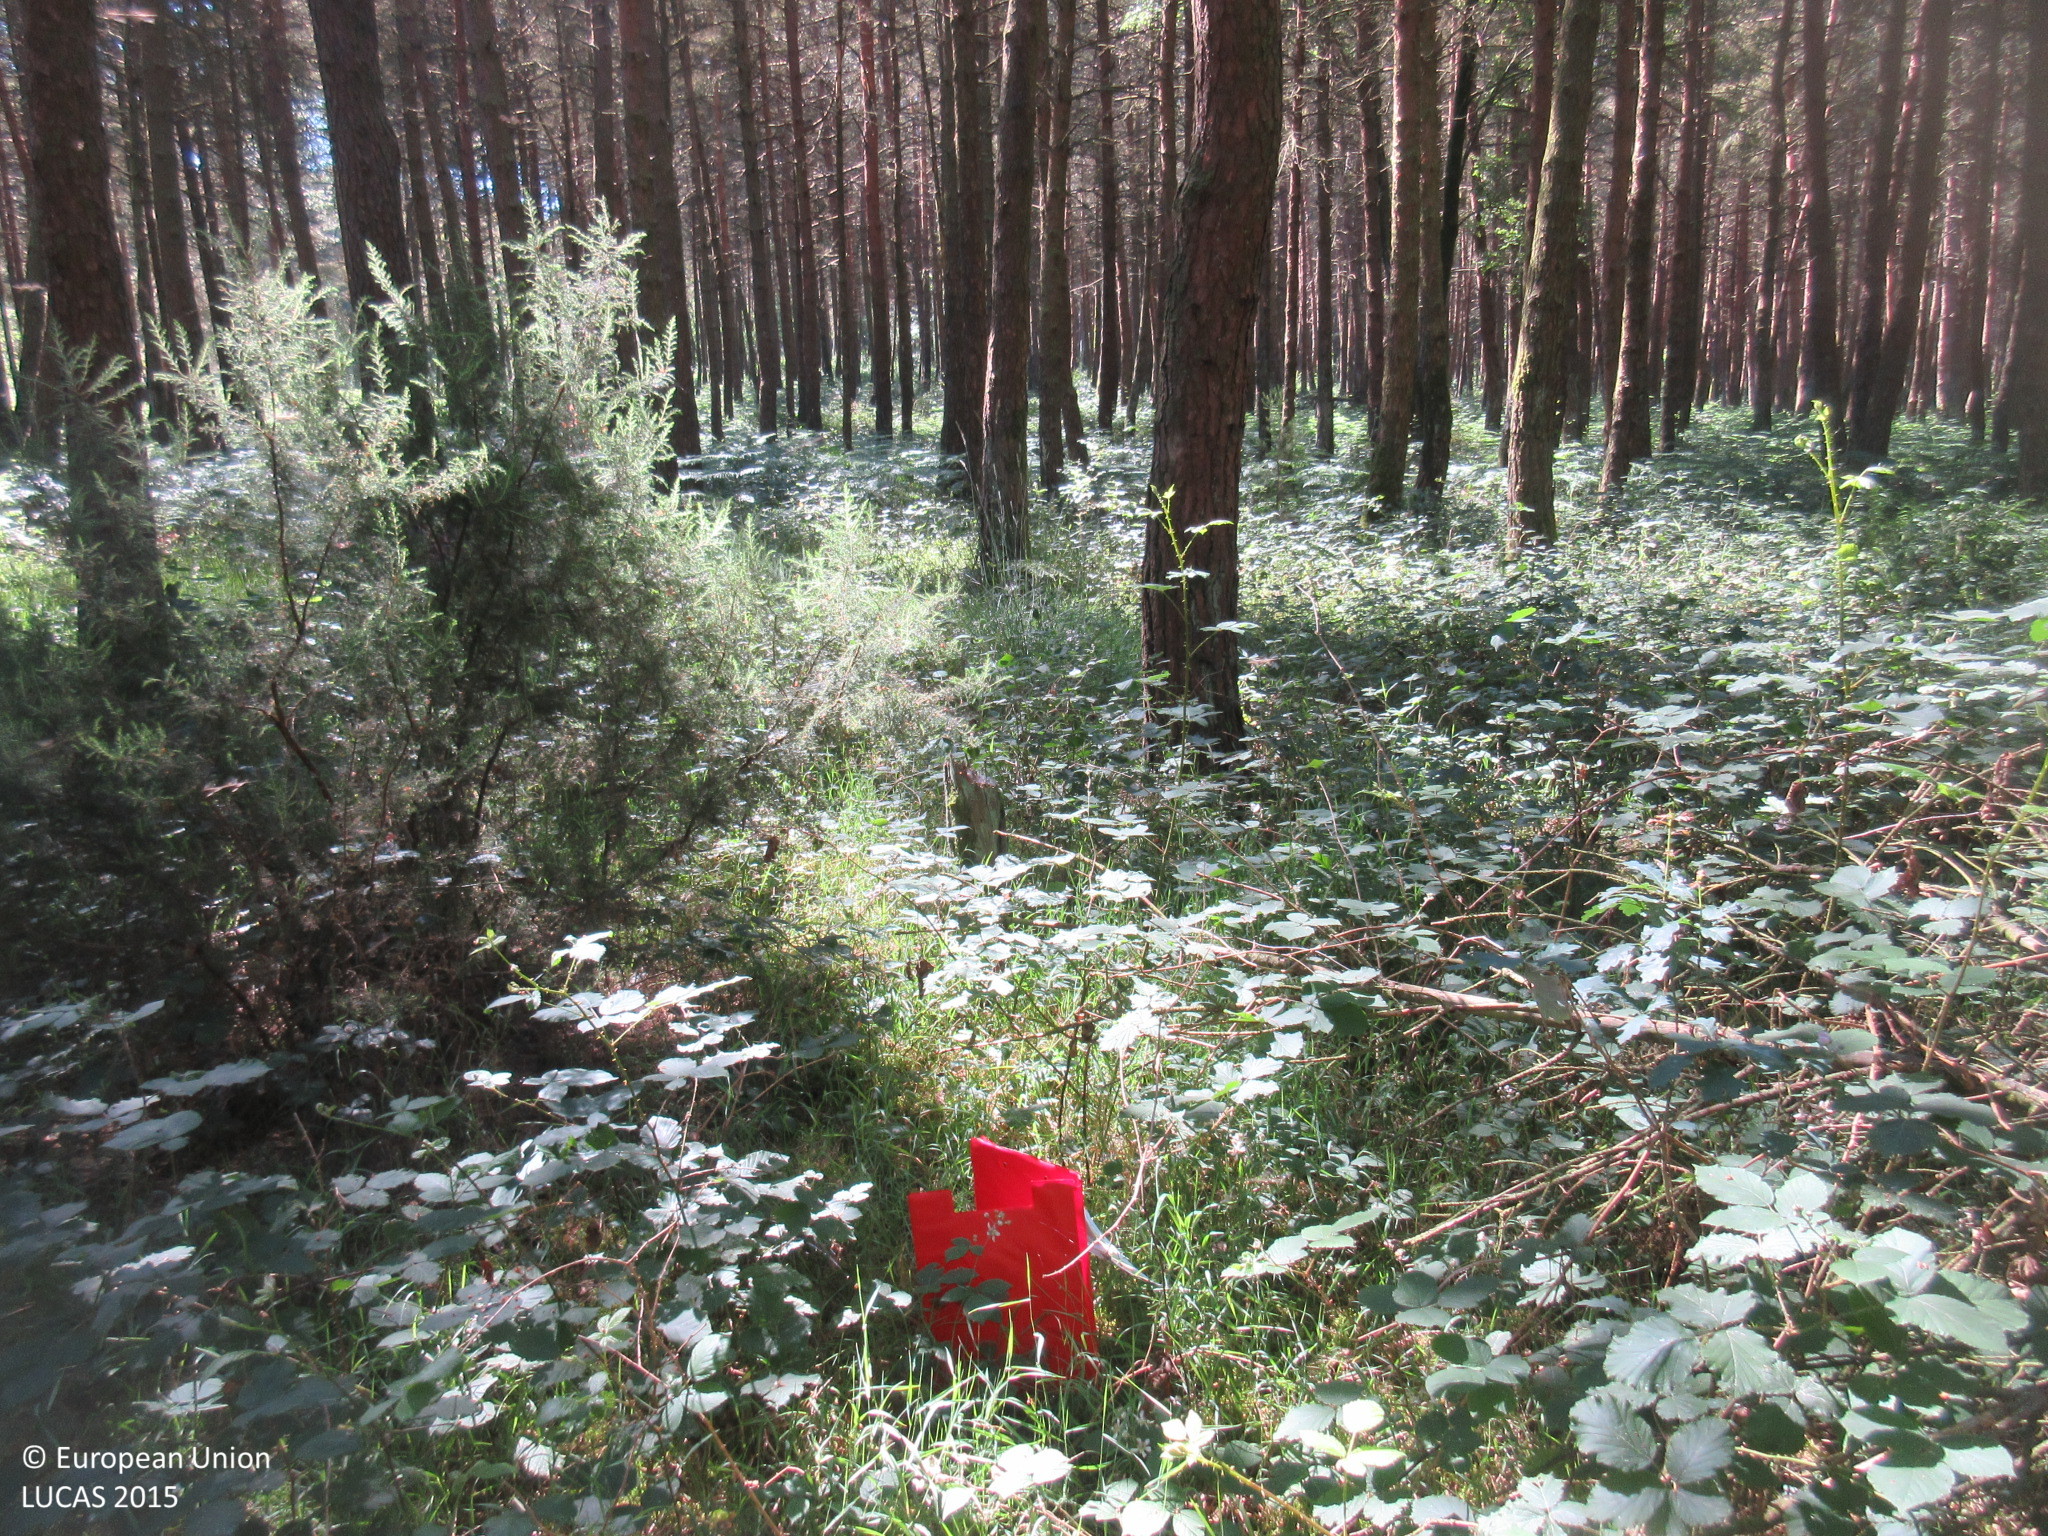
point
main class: Woodland
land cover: Pine dominated coniferous woodland
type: hemiboreal forest and nemoral coniferous forest and mixed broadleaved-coniferous forest
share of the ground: > 75 %
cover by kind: coniferous forest trees 95 %, shrubs 5 %
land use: Forestry
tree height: > 5 m
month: June
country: ES
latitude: 43.1751
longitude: -7.1048
